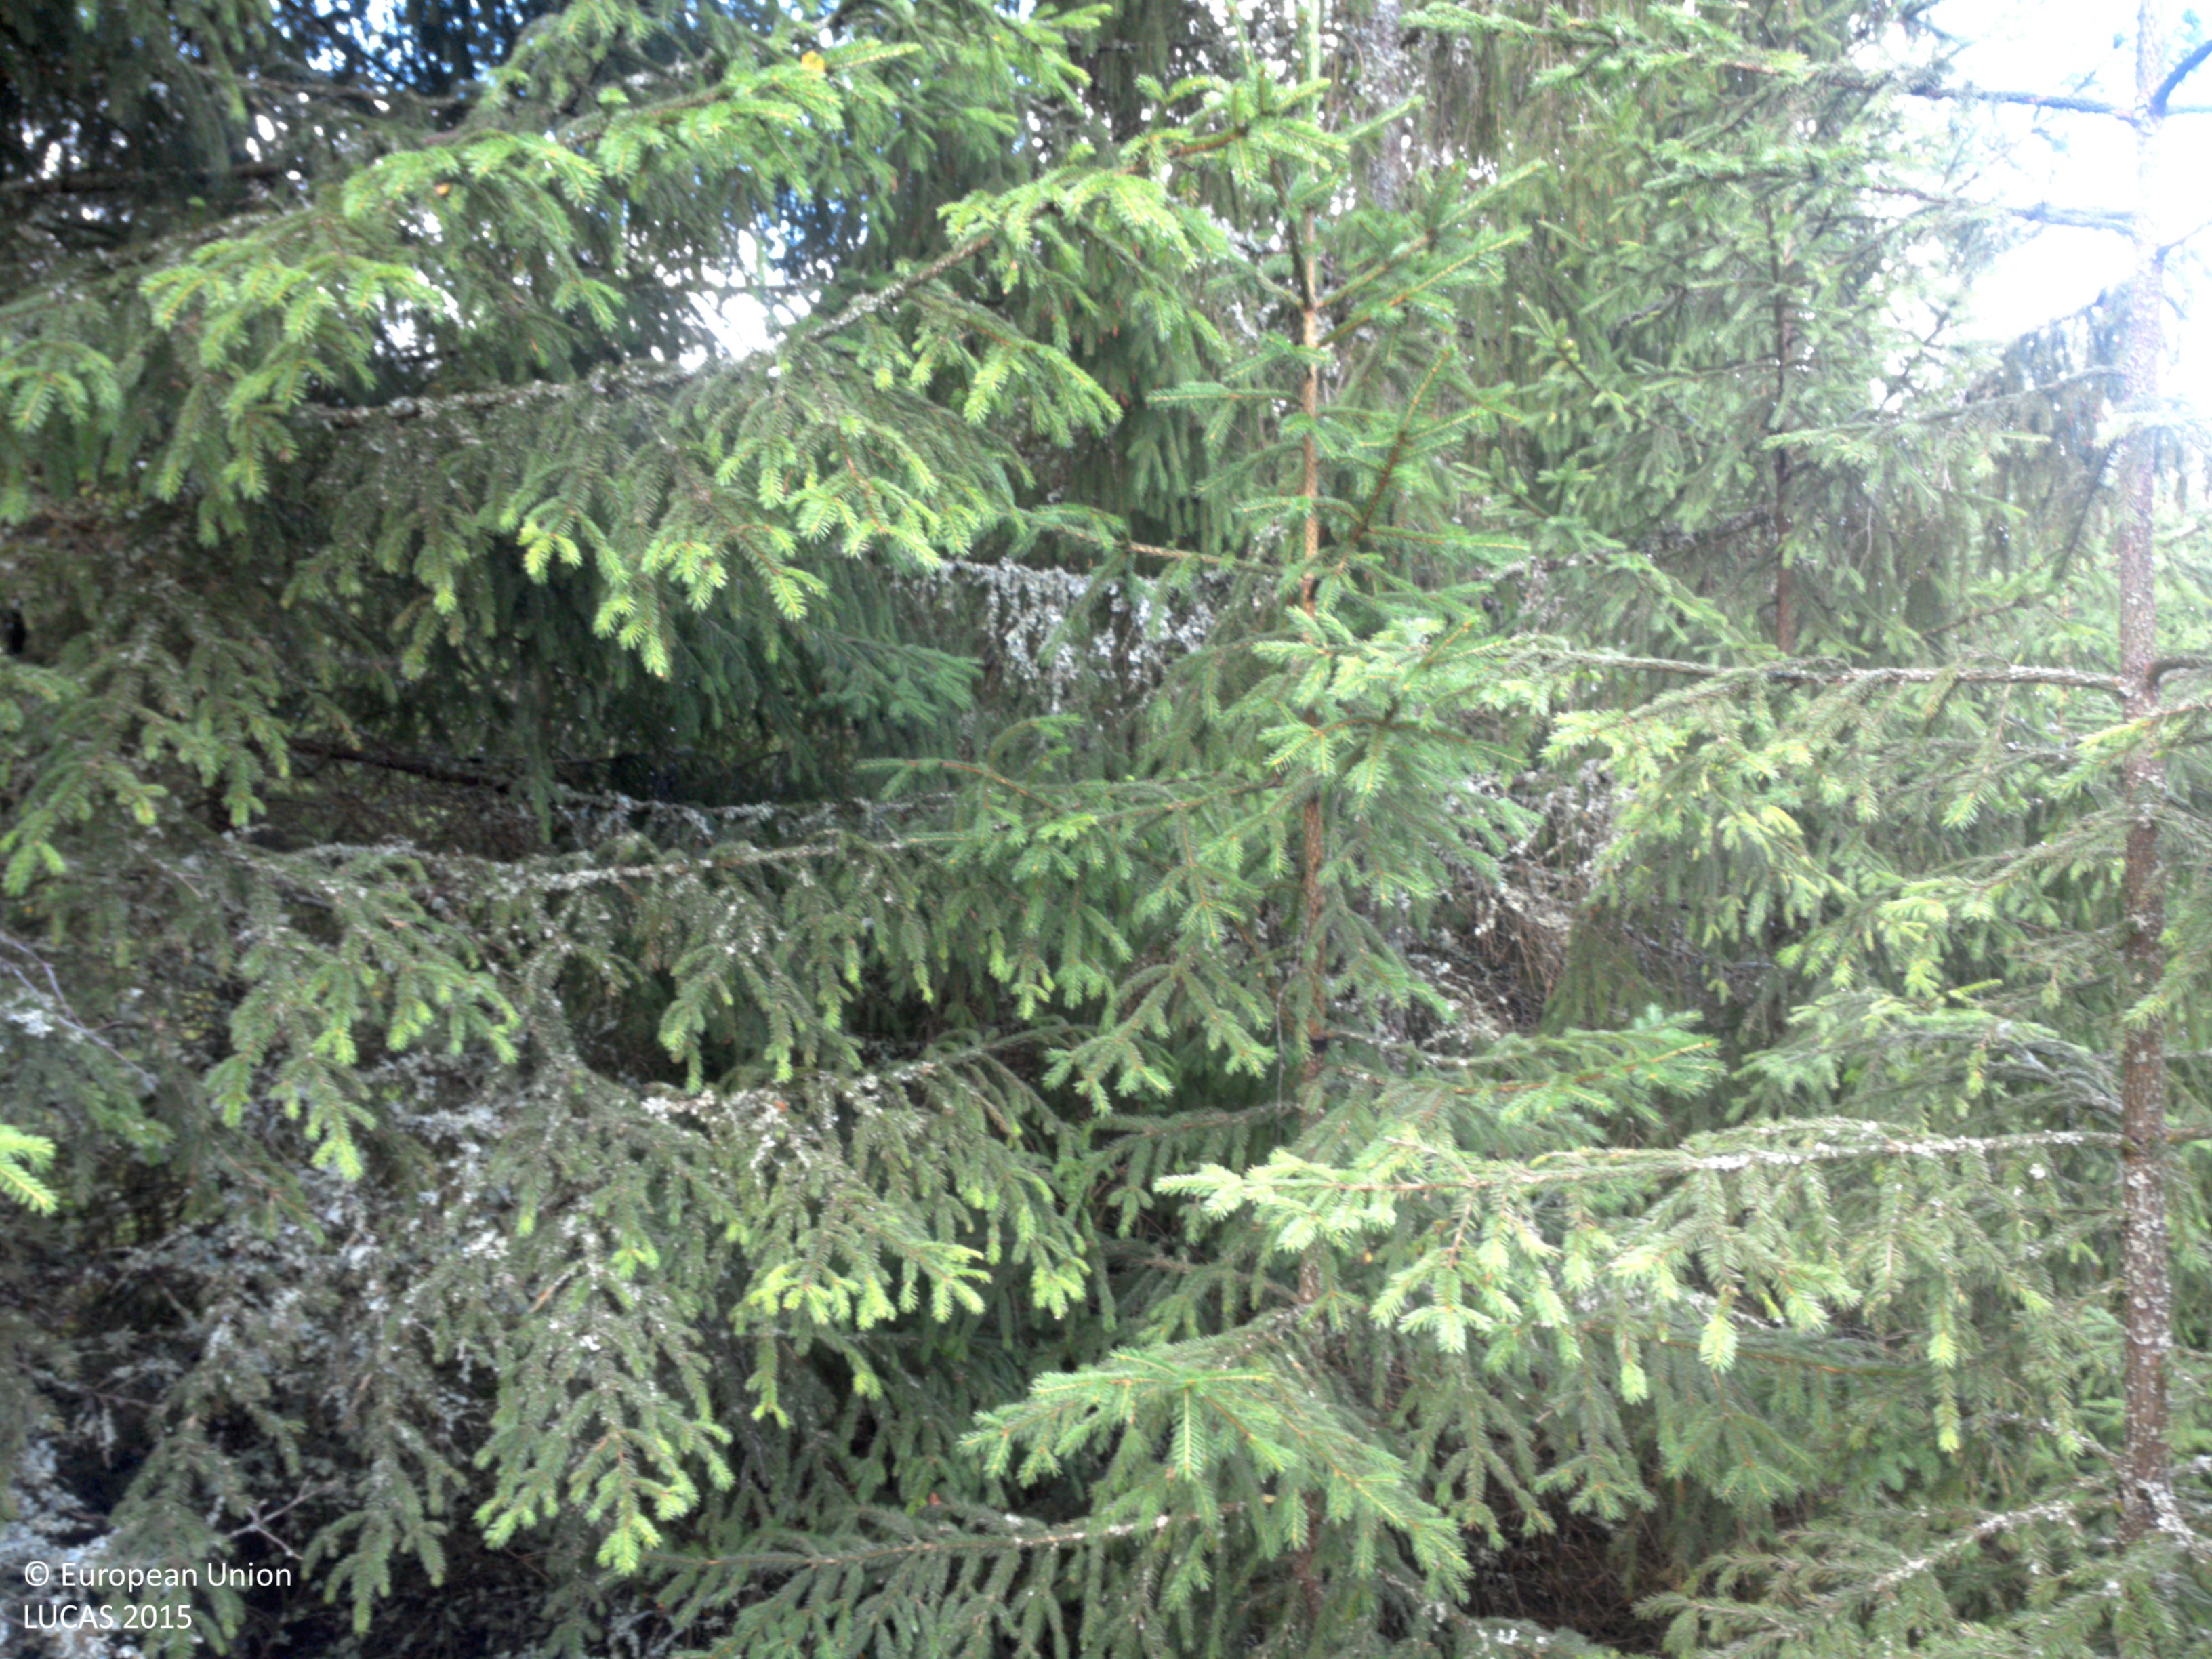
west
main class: Woodland
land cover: Spruce dominated mixed woodland
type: boreal forest
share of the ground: 50 - 75 %
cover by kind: coniferous forest trees 40 %, herbaceous plants 30 %, broadleaved forest trees 20 %, lichens and mosses 10 %
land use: Forestry
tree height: > 5 m
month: July
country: SE
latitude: 58.6373
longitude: 11.9424
